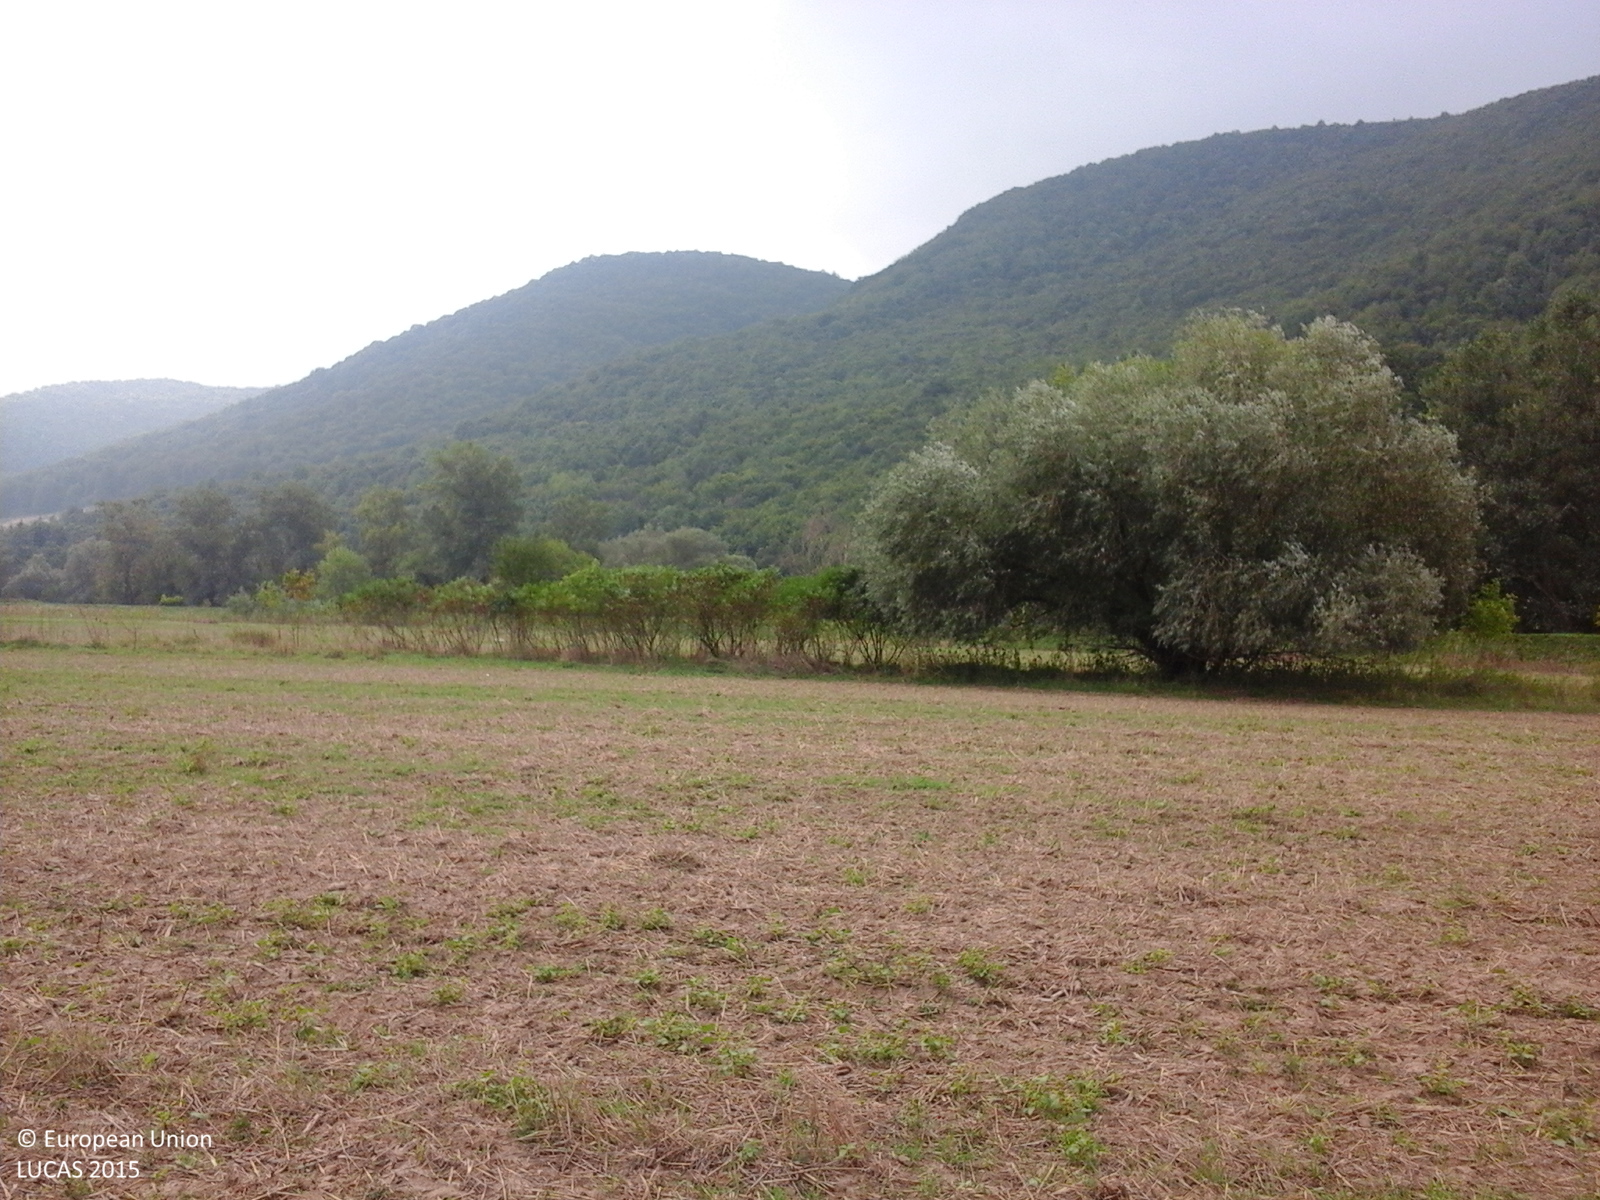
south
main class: Cropland
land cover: Common wheat
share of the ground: 10 - 25 %
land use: Agriculture (excluding fallow land and kitchen gardens)
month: September
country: RO
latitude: 45.9095
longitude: 22.7759
